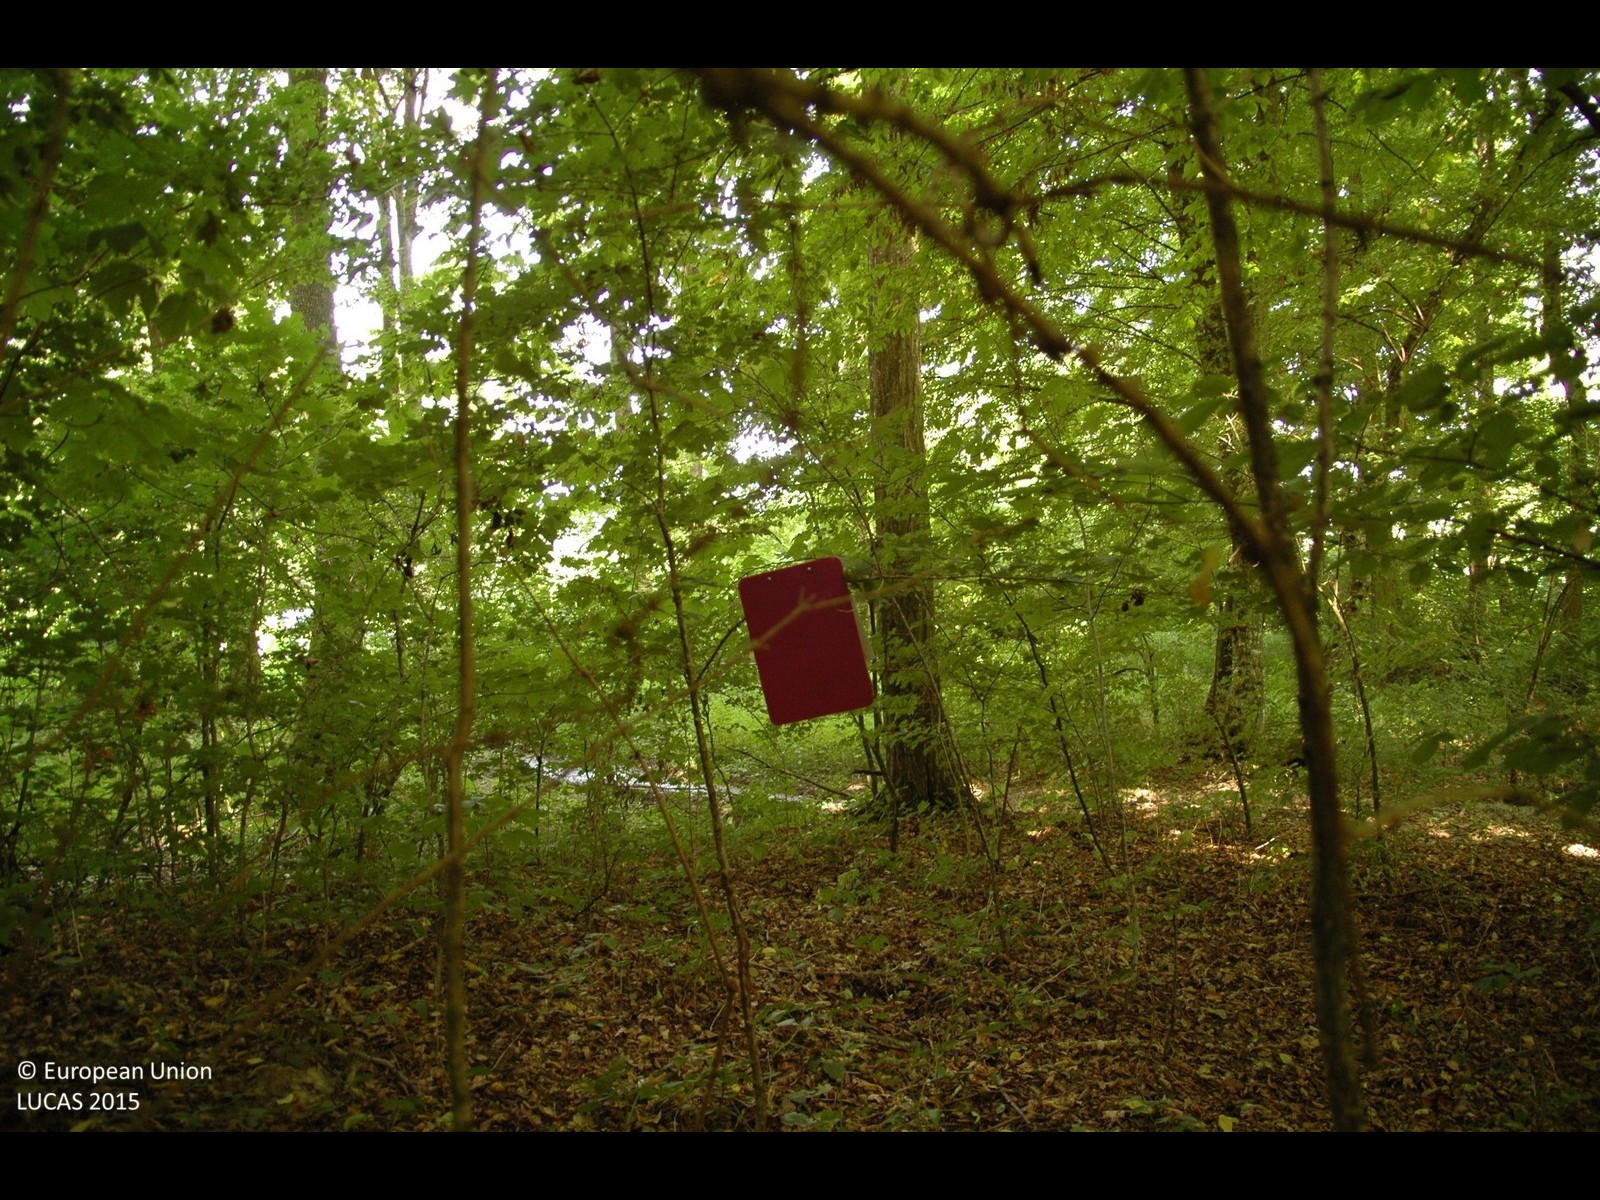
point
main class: Woodland
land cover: Broadleaved woodland
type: mesophytic deciduous forest
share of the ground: > 75 %
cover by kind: broadleaved forest trees 100 %
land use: Forestry
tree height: > 5 m
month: July
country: HR
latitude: 46.1626
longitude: 16.6442
